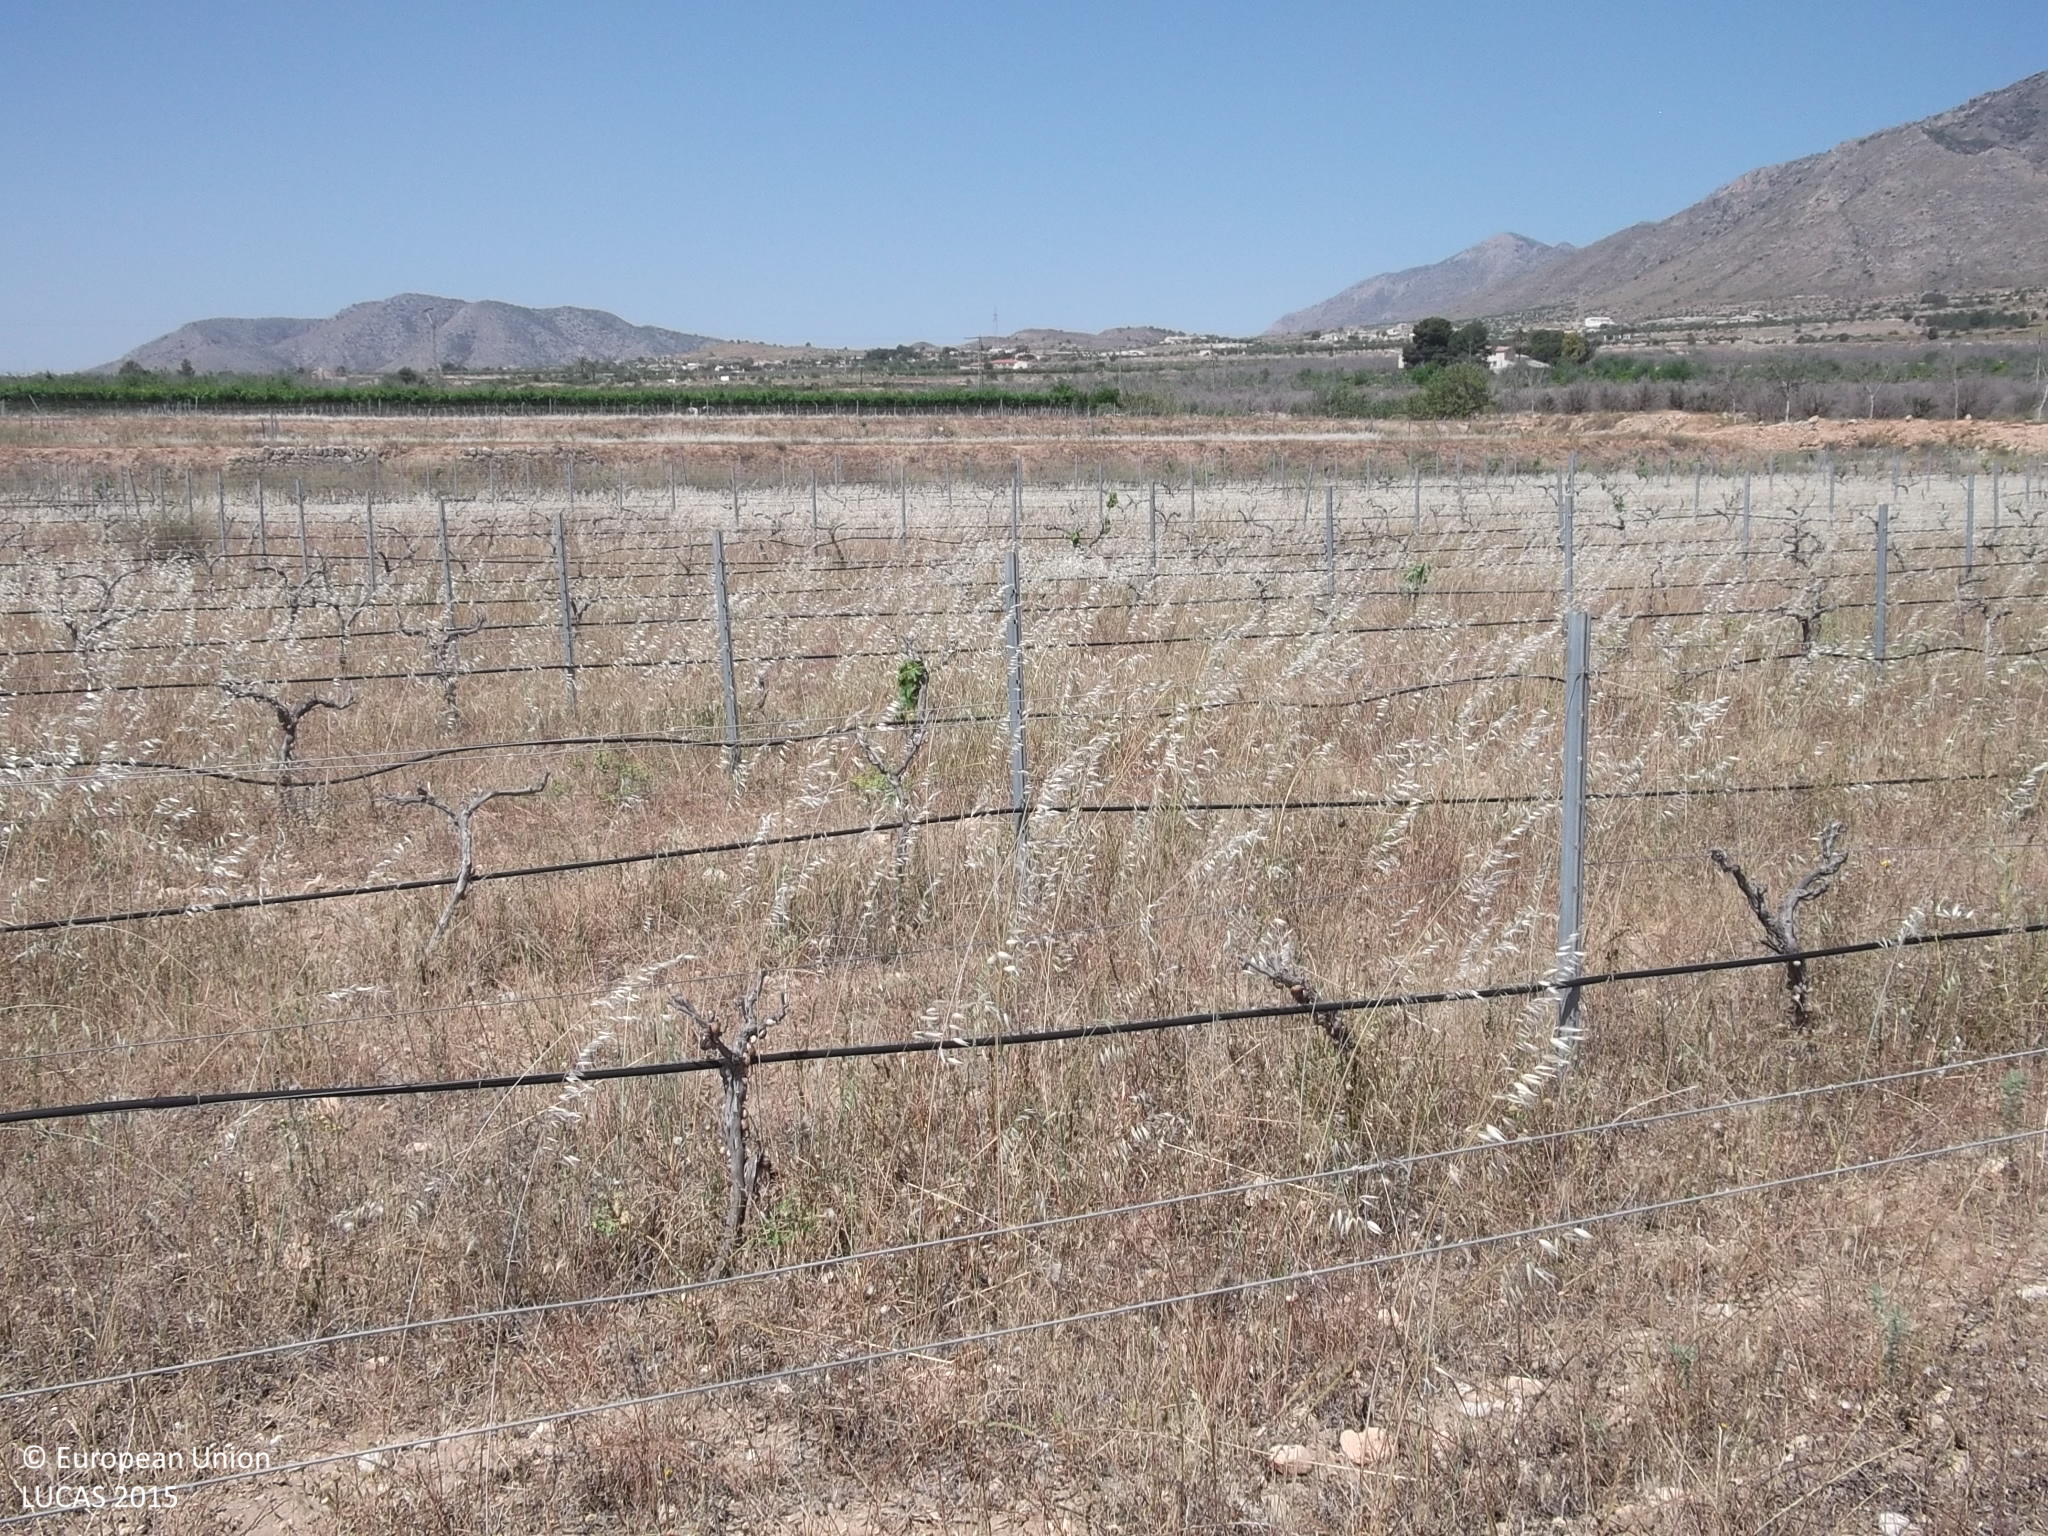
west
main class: Cropland
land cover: Vineyards
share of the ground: < 10 %
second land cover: Grassland without tree/shrub cover
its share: > 75 %
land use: Agriculture (excluding fallow land and kitchen gardens)
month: May
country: ES
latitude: 38.3088
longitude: -0.8853
